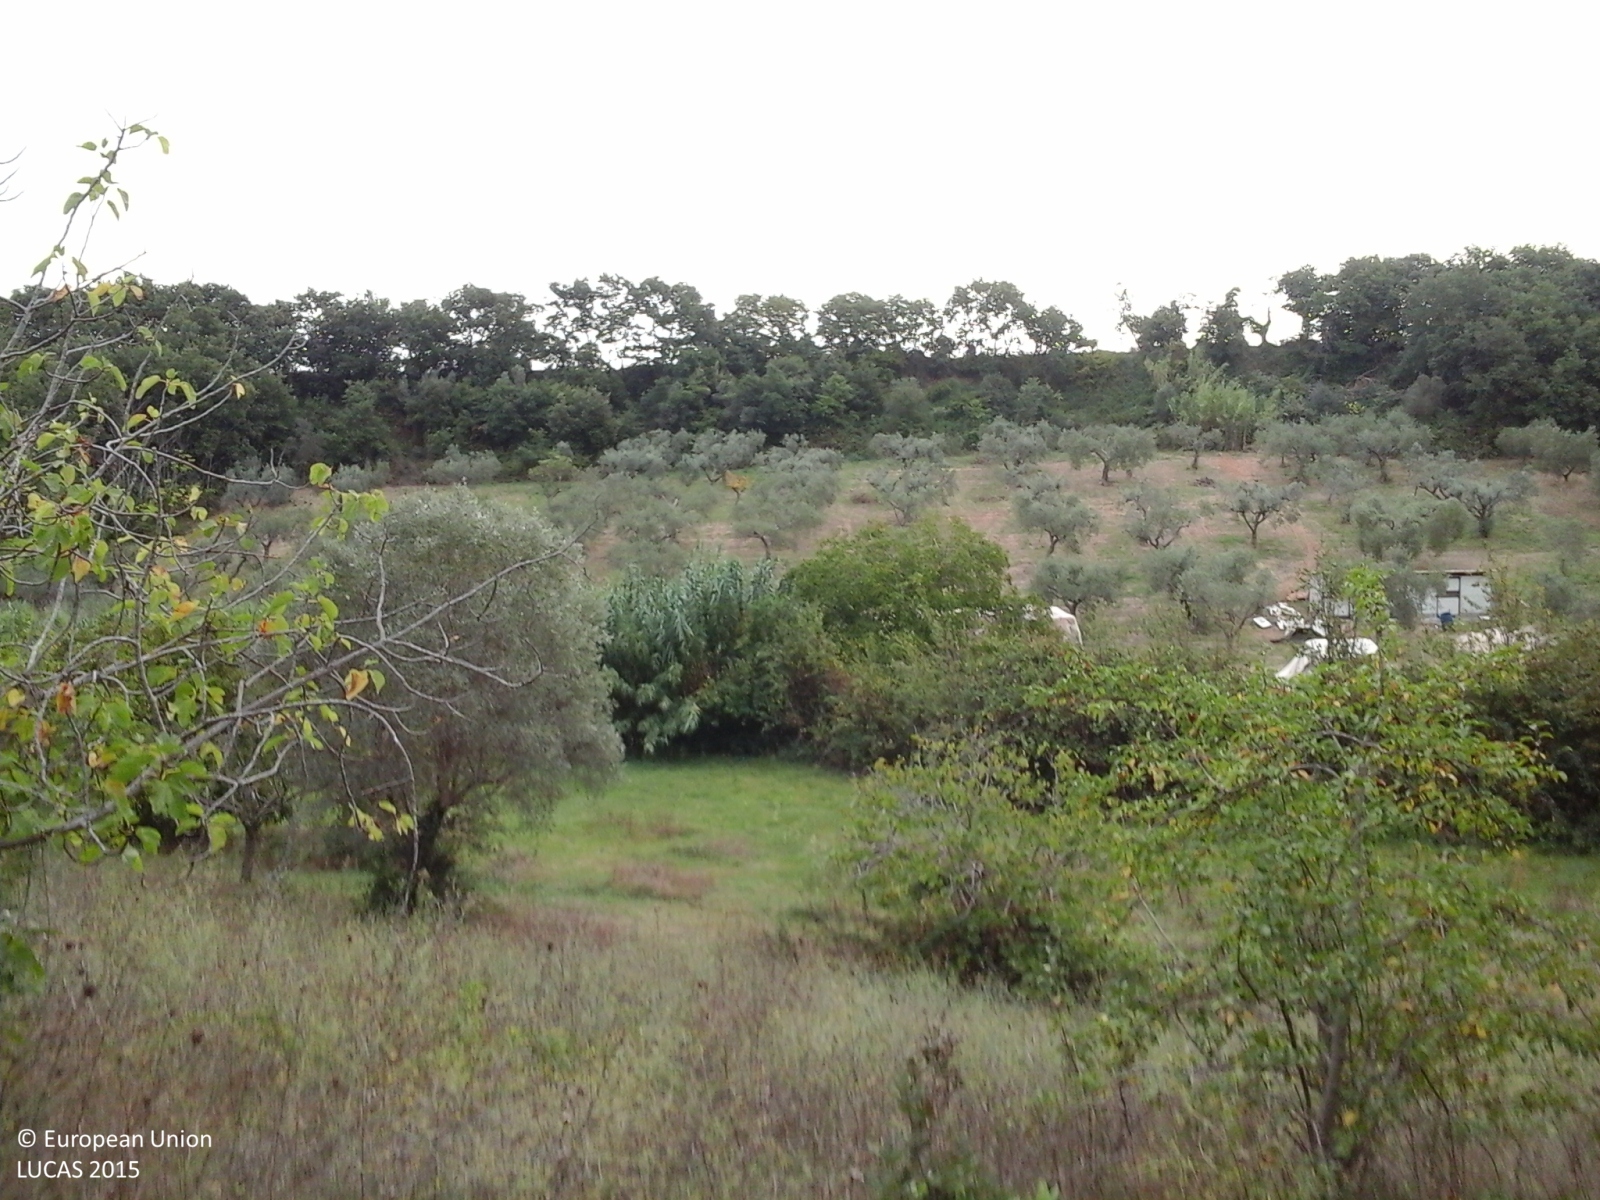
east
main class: Cropland
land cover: Apple fruit
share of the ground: > 75 %
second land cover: Spontaneously vegetated surfaces
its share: > 75 %
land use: Agriculture (excluding fallow land and kitchen gardens)
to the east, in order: Apple fruit; Spontaneously vegetated surfaces; Shrubland without tree cover; Ditches and canals; Spontaneously vegetated surfaces; Olive groves; Broadleaved woodland; Durum wheat; Broadleaved woodland
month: September
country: IT
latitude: 41.8520
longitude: 15.1754
